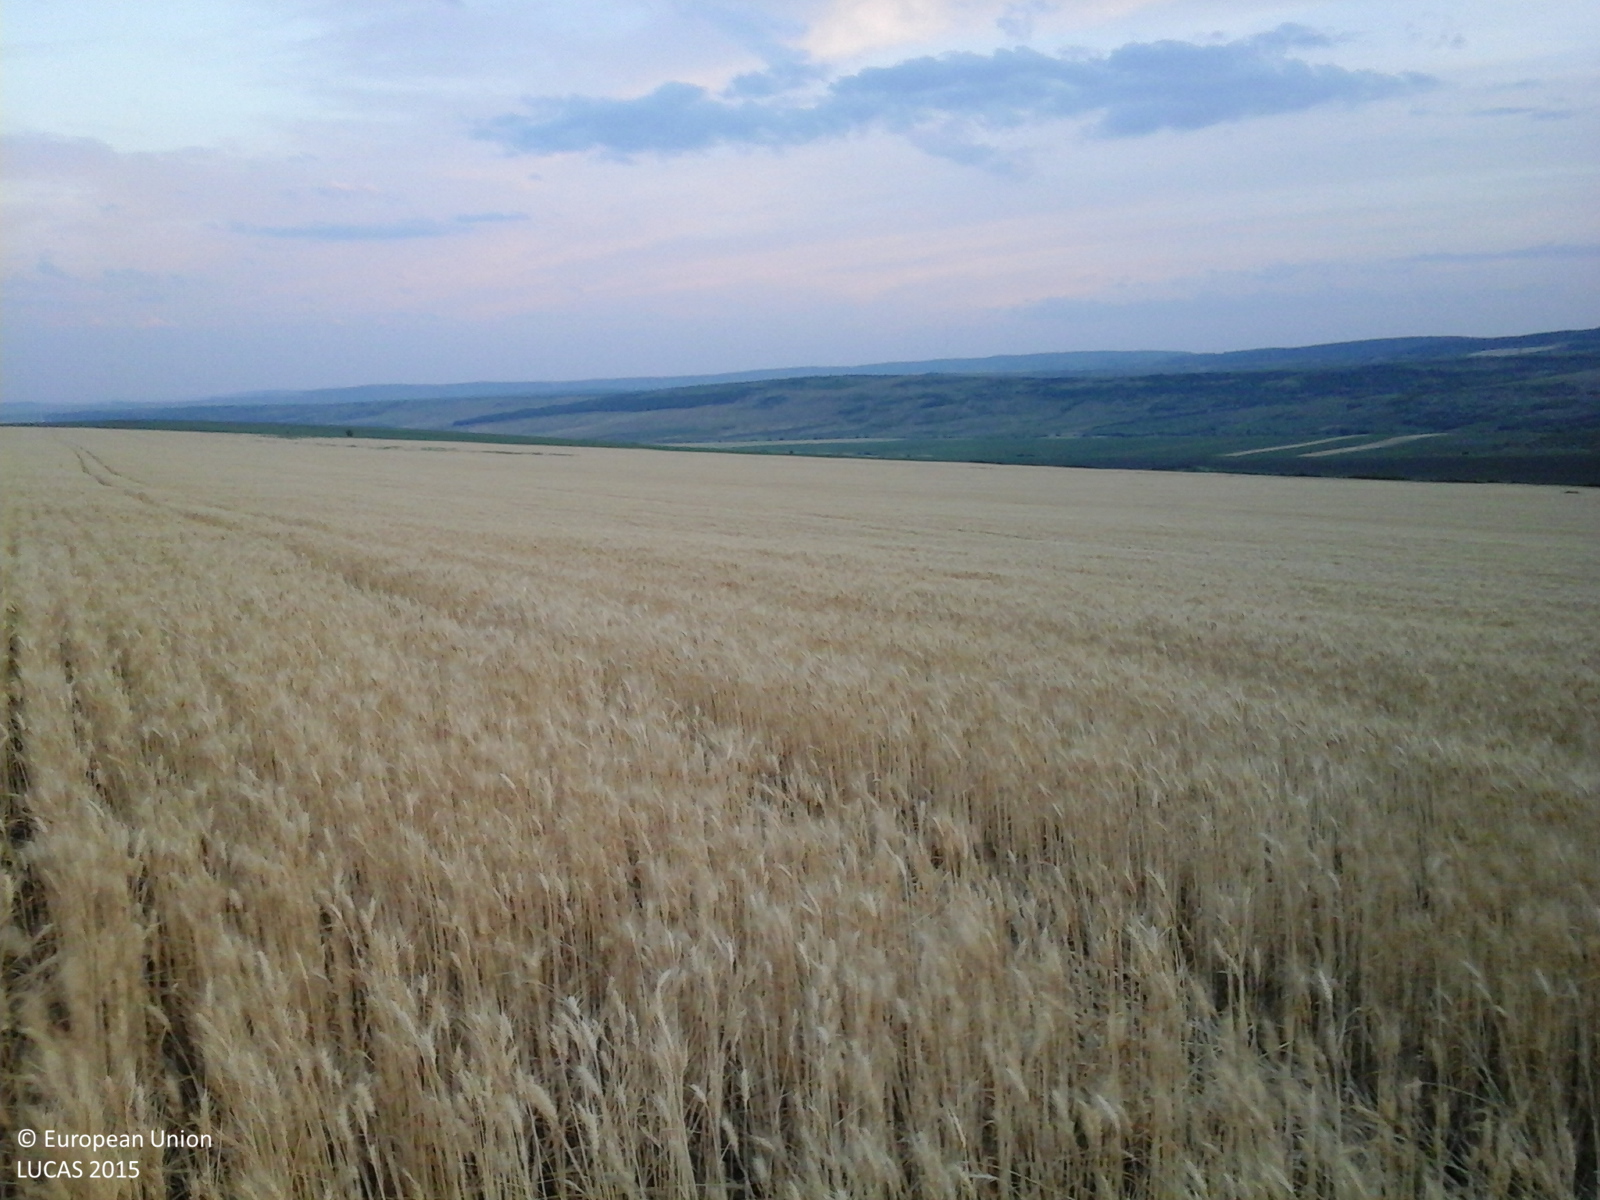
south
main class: Cropland
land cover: Common wheat
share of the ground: > 75 %
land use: Agriculture (excluding fallow land and kitchen gardens)
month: June
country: RO
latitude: 46.7880
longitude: 28.0641
